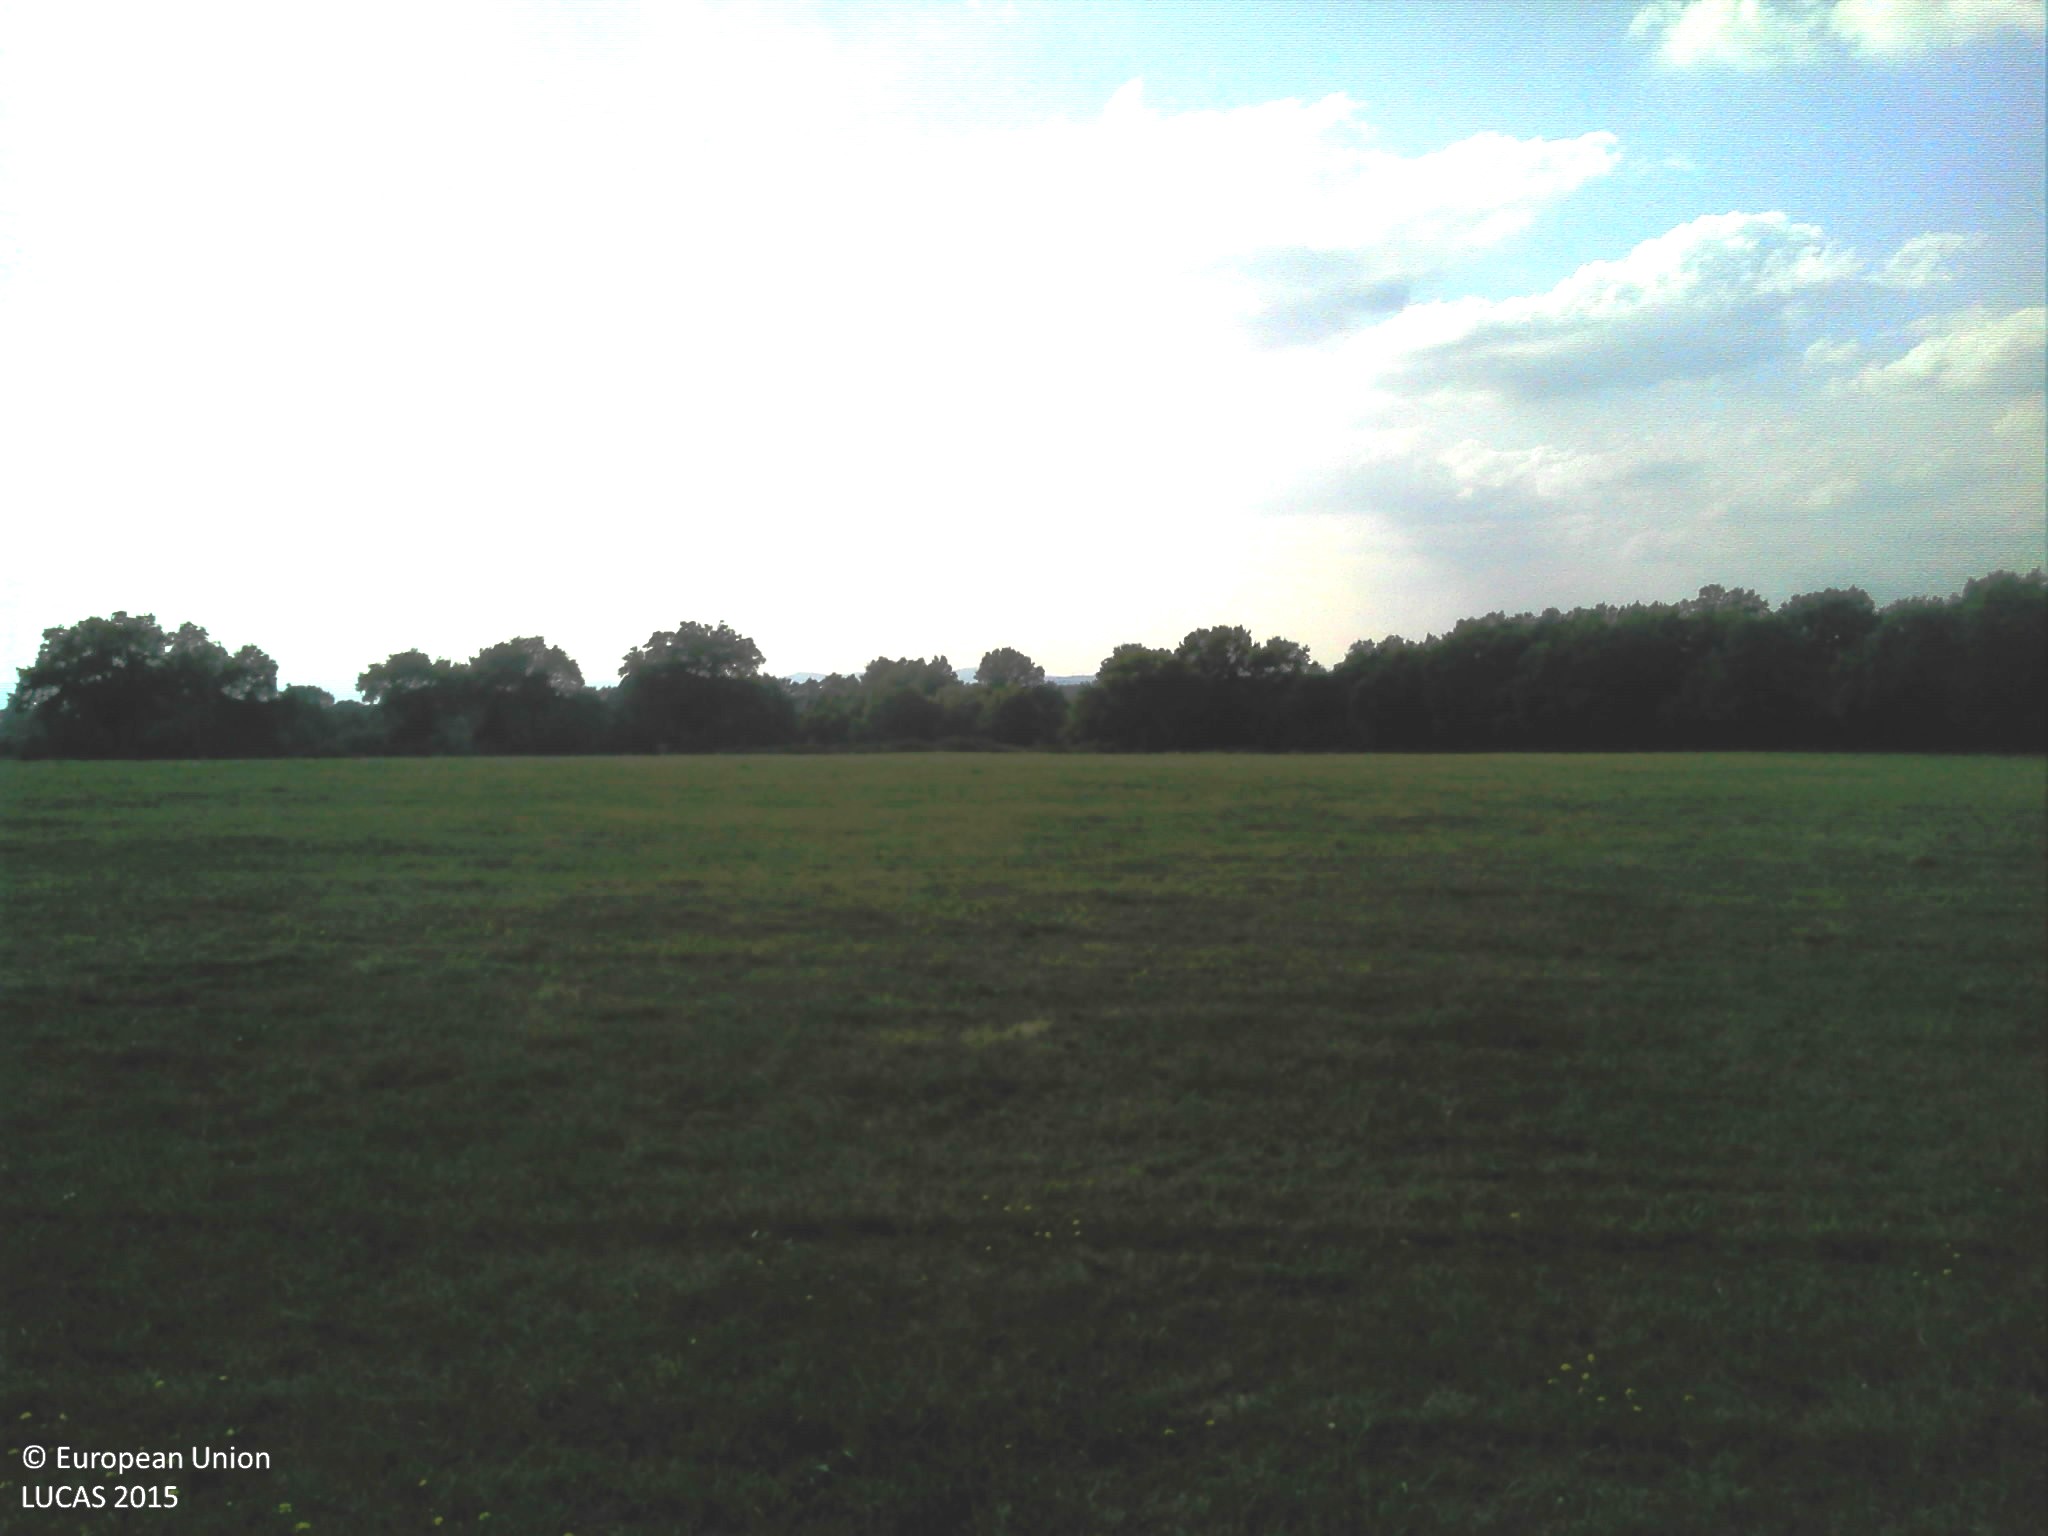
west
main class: Grassland
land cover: Grassland without tree/shrub cover
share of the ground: > 75 %
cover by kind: herbaceous plants 100 %
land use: Agriculture (excluding fallow land and kitchen gardens)
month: August
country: FR
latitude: 47.0159
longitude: 4.3827
